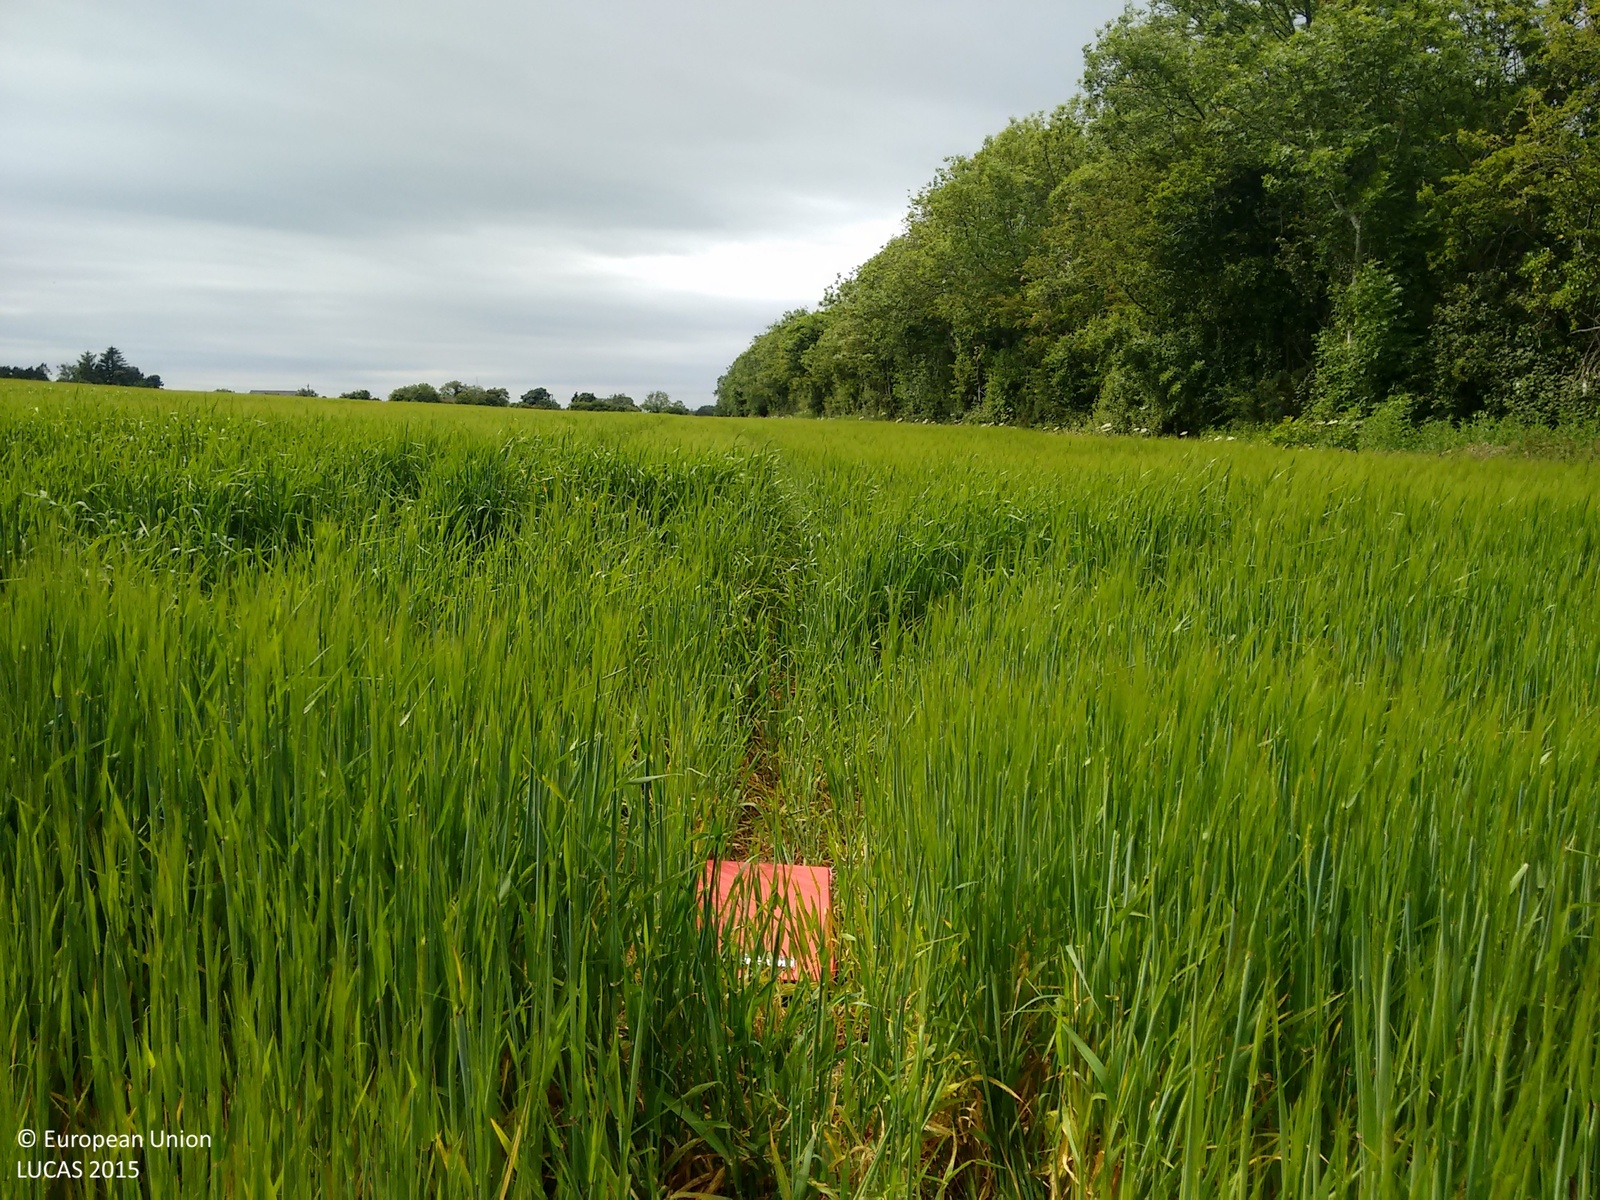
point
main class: Cropland
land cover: Common wheat
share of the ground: > 75 %
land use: Agriculture (excluding fallow land and kitchen gardens)
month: June
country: IE
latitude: 53.5369
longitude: -6.1557
